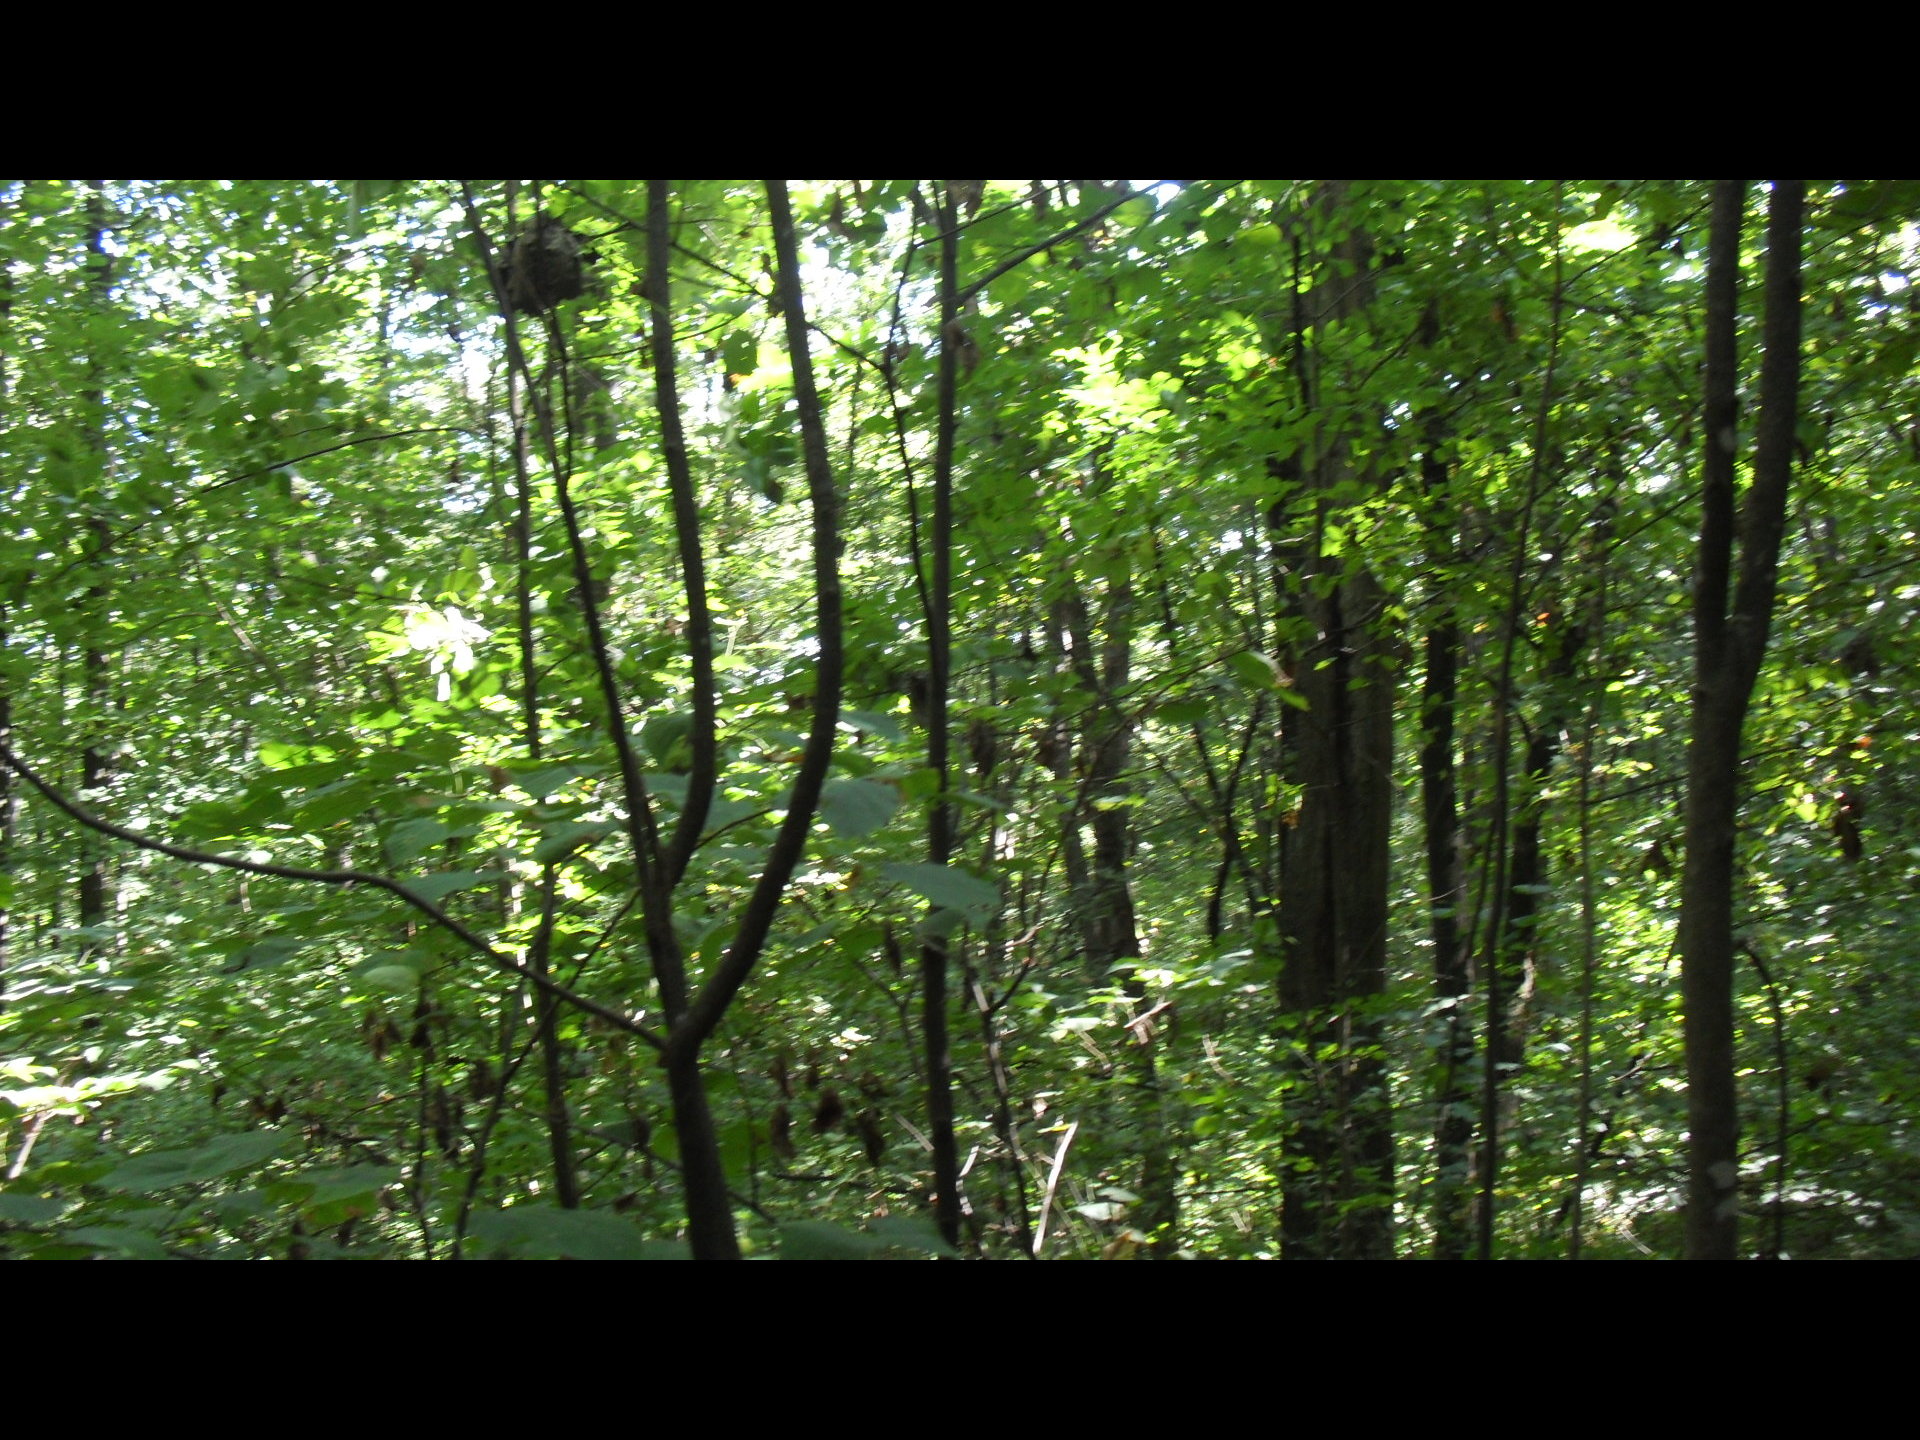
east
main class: Woodland
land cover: Broadleaved woodland
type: mesophytic deciduous forest
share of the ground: > 75 %
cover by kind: broadleaved forest trees 100 %
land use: Forestry
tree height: > 5 m
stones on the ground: < 10 %
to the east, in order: Broadleaved woodland; Fences; Broadleaved woodland
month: October
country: BG
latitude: 43.8893
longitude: 22.7461
